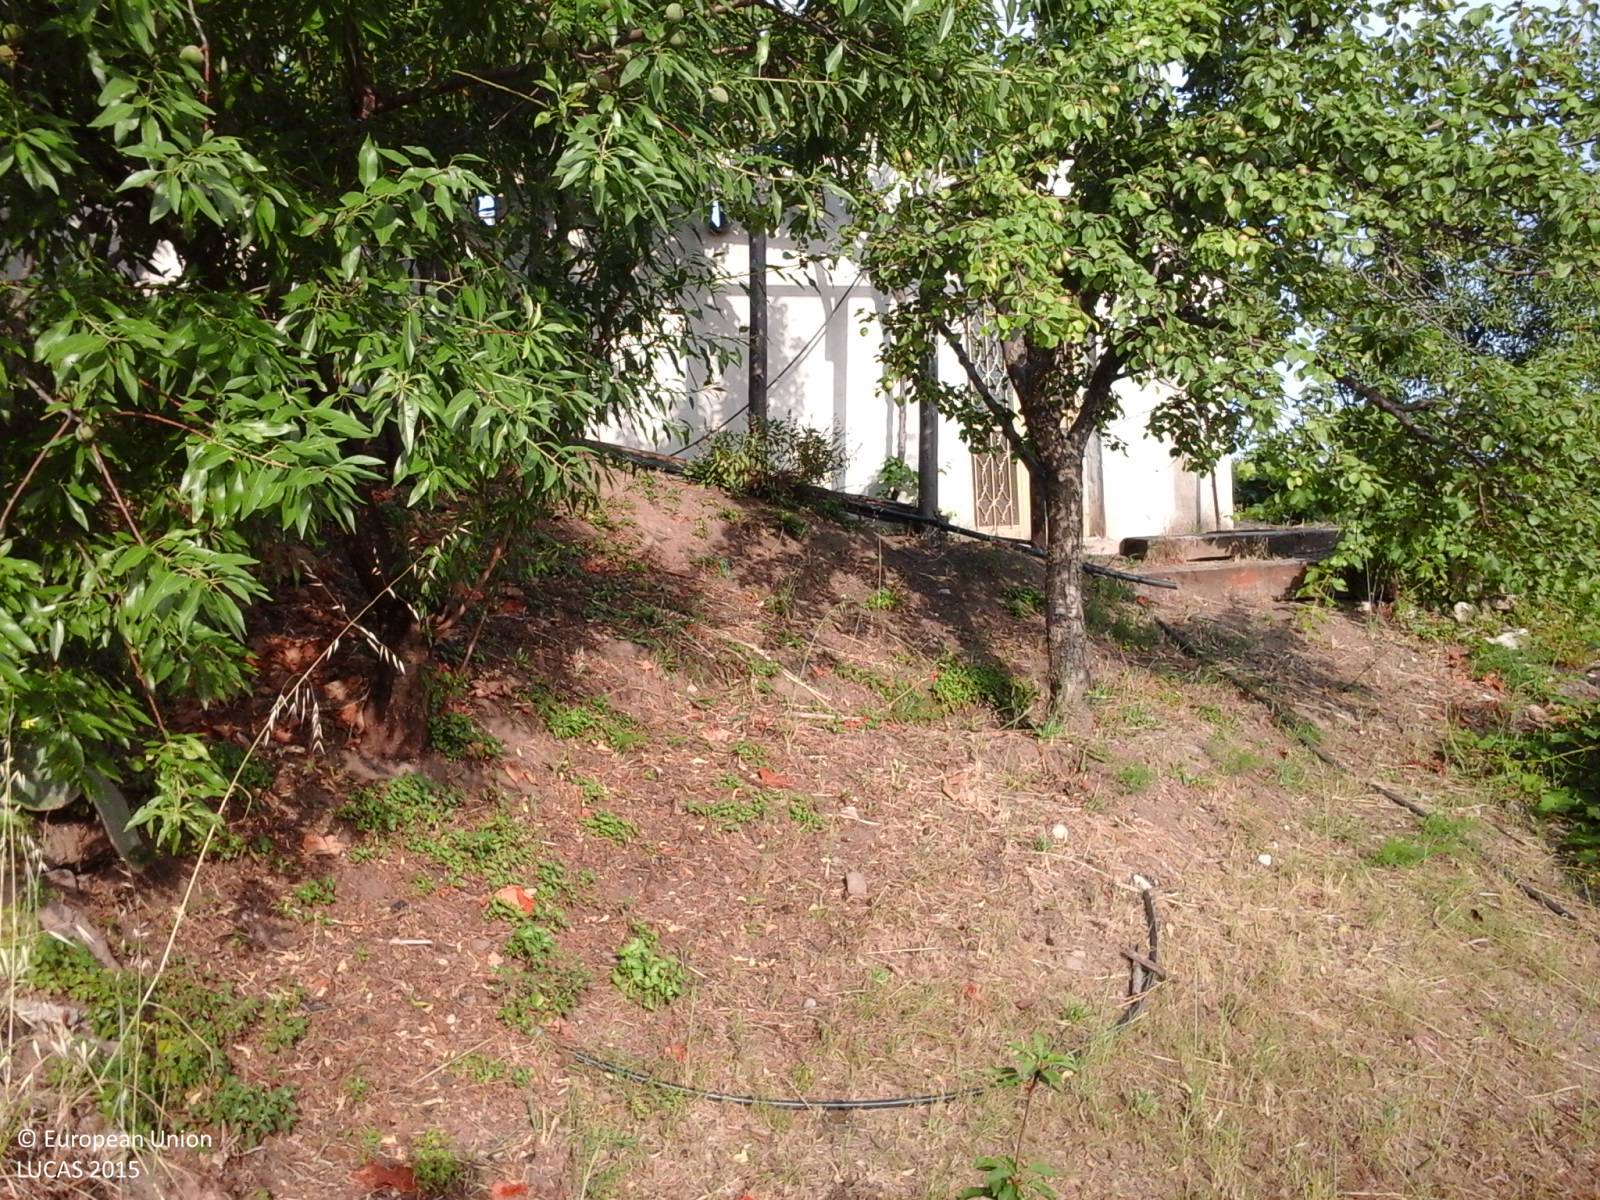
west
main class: Grassland
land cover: Grassland with sparse tree/shrub cover
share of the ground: < 10 %
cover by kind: herbaceous plants 40 %, consolidated bare surface 15 %, shrubs 10 %, coniferous forest trees 5 %
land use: Agriculture (excluding fallow land and kitchen gardens)
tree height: < 5 m
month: June
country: IT
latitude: 40.8917
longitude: 8.6650
